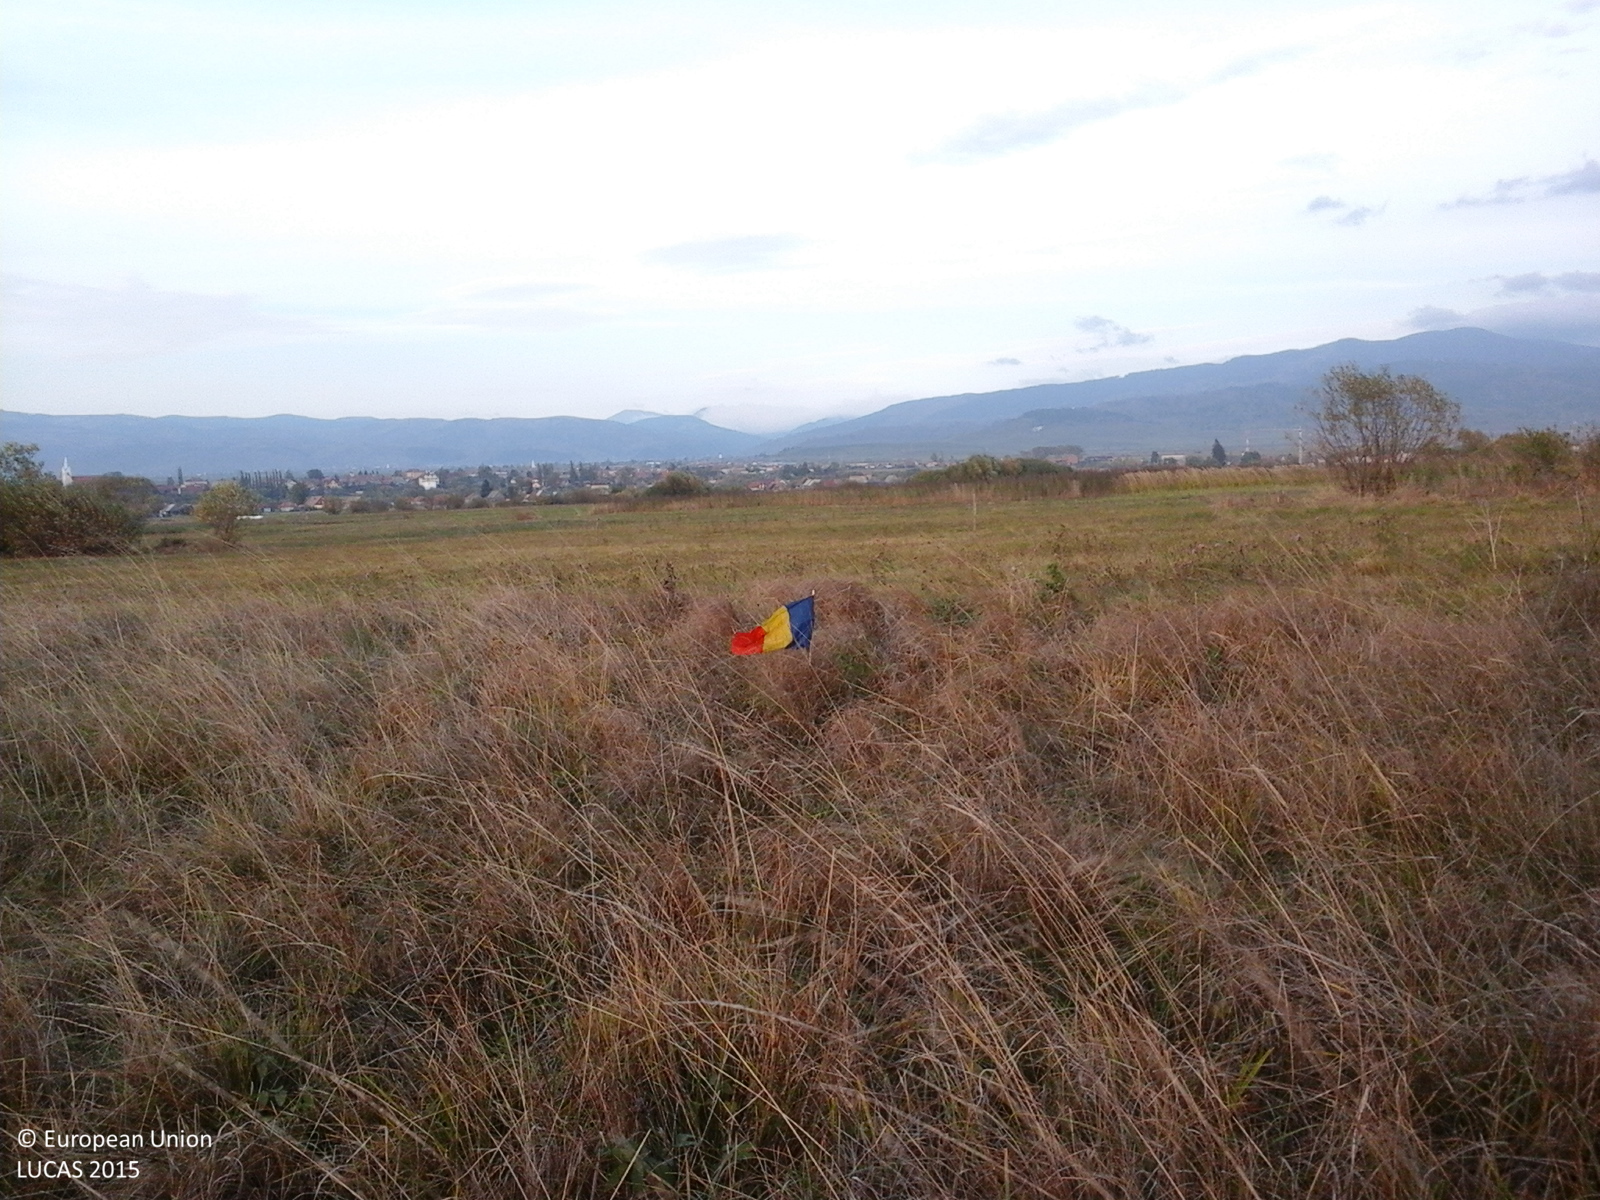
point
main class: Grassland
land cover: Grassland without tree/shrub cover
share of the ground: > 75 %
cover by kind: herbaceous plants 100 %
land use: Agriculture (excluding fallow land and kitchen gardens)
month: October
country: RO
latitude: 46.6541
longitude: 25.5434
